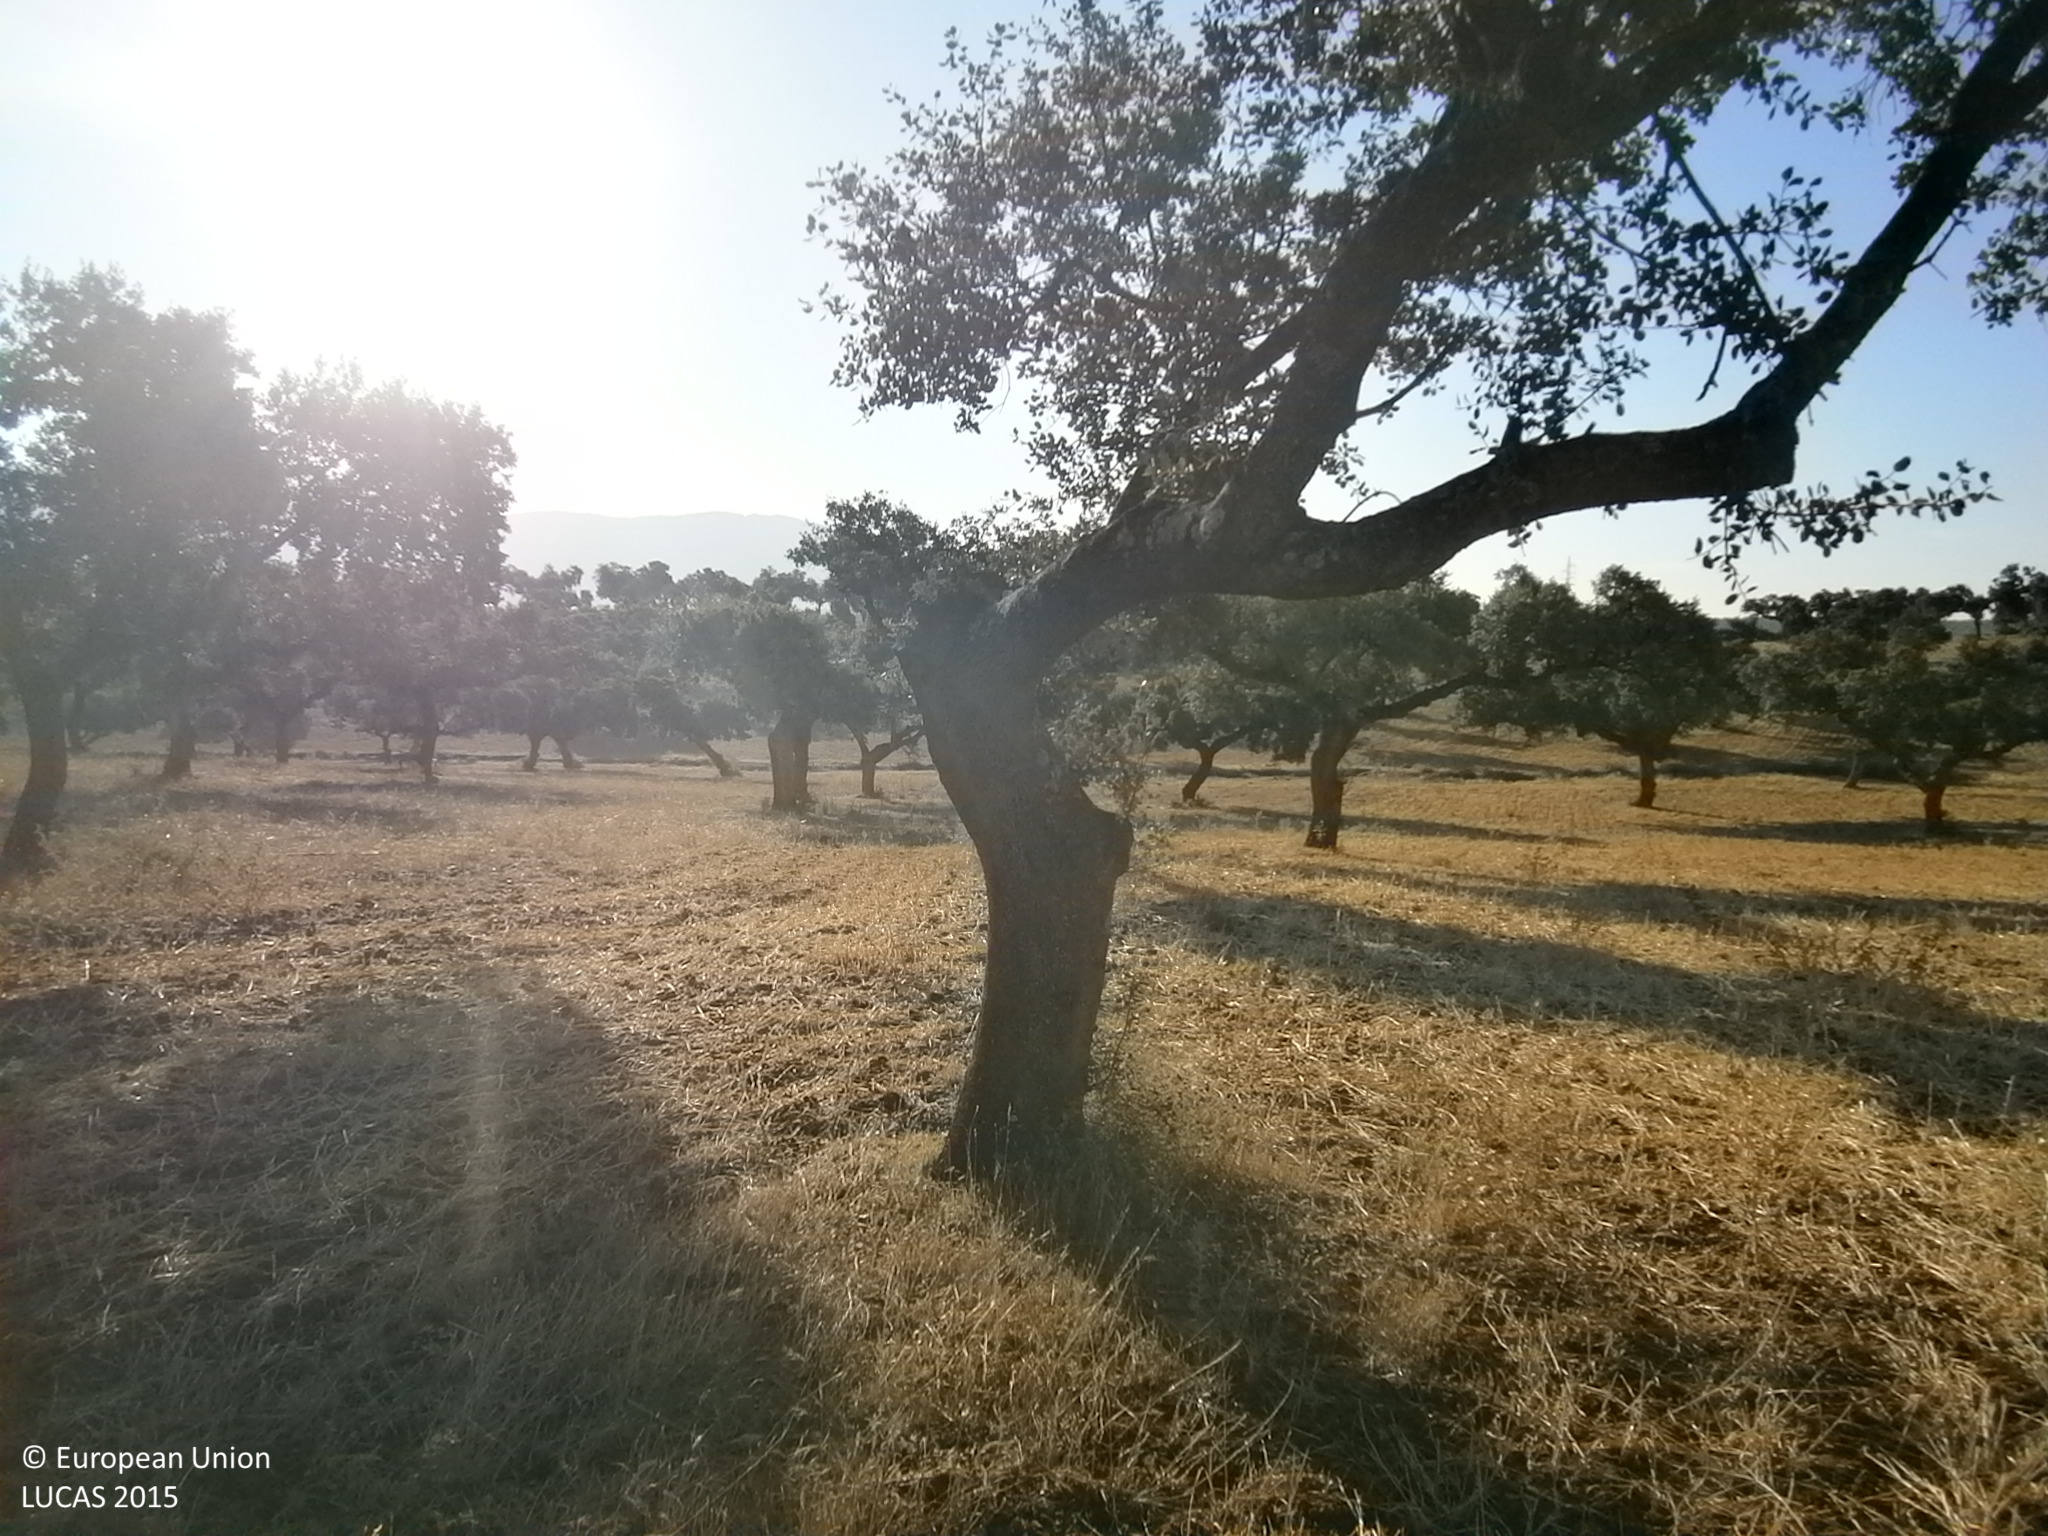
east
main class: Woodland
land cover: Broadleaved woodland
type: broadleaved evergreen forest
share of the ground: 50 - 75 %
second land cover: Spontaneously vegetated surfaces
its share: 50 - 75 %
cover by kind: broadleaved forest trees 45 %, herbaceous plants 45 %, shrubs 5 %, unconsolidated bare surface 5 %
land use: Forestry
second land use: Agriculture (excluding fallow land and kitchen gardens)
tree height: > 5 m
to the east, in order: Broadleaved woodland; Spontaneously vegetated surfaces; Rivers and streams; Broadleaved woodland
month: June
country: ES
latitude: 38.8449
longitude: -6.4773
